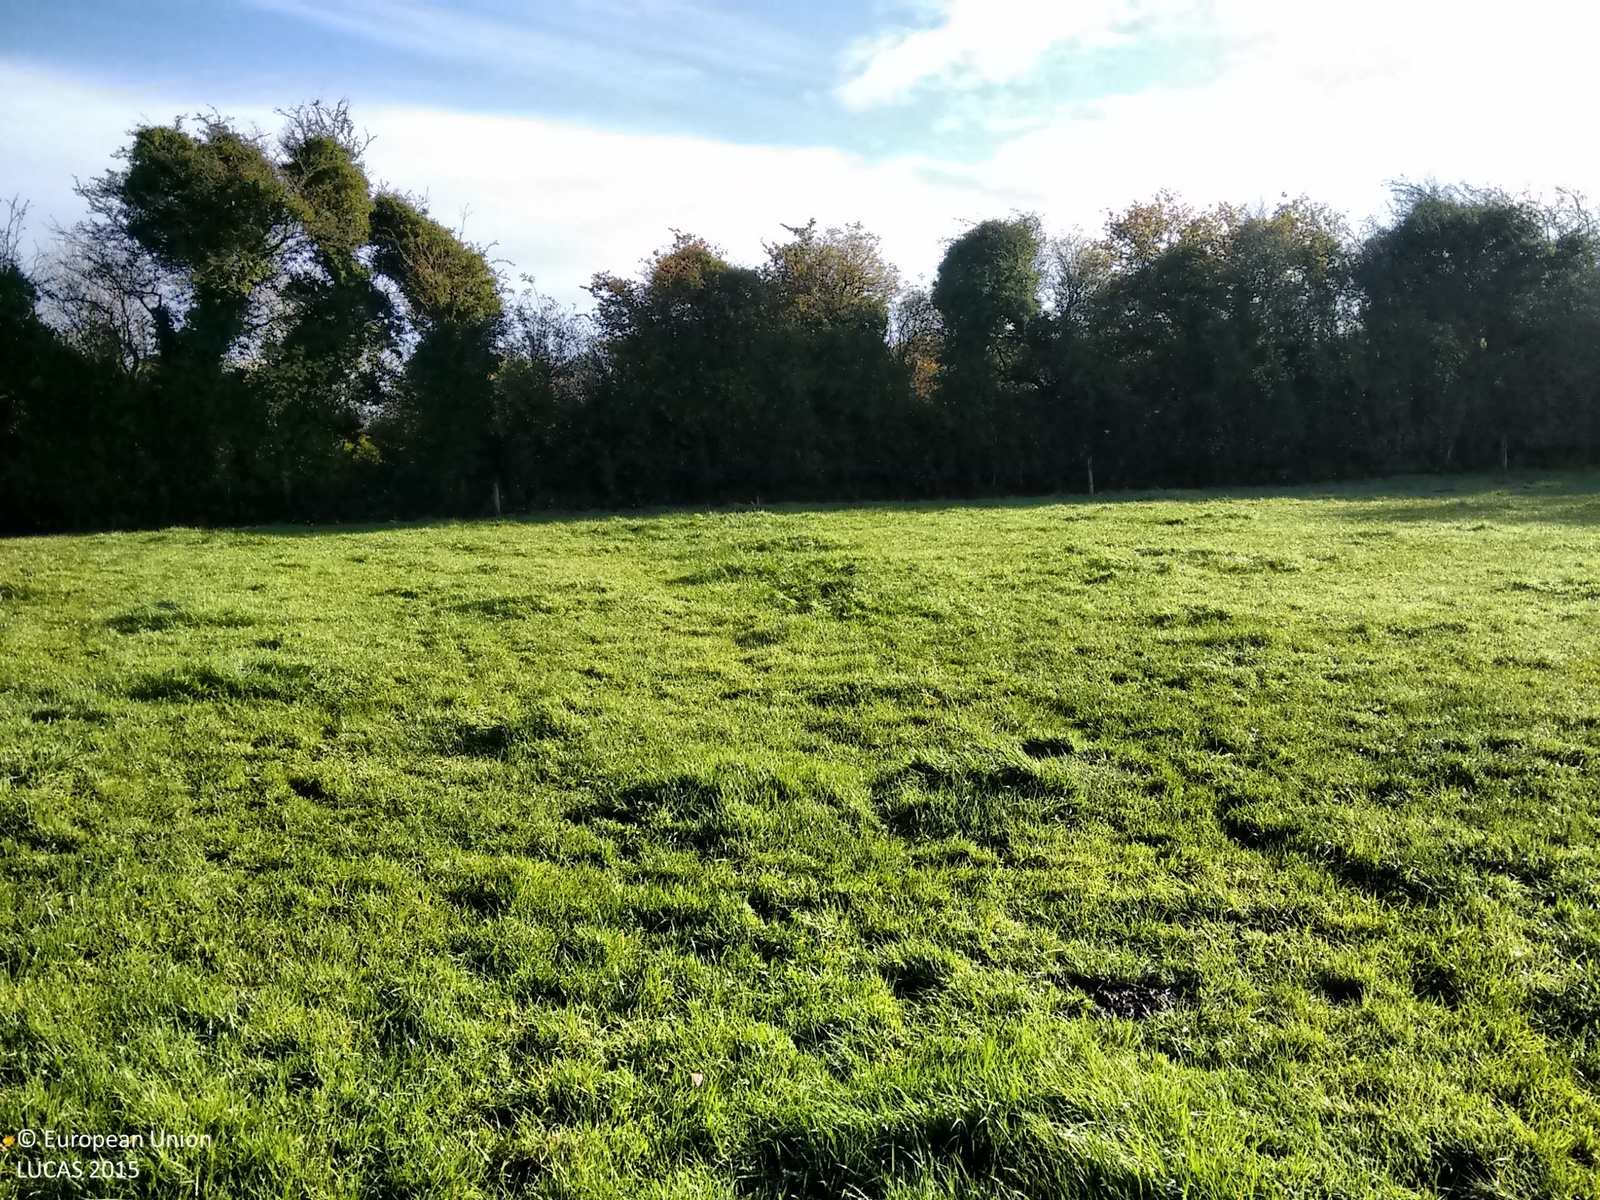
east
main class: Grassland
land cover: Grassland without tree/shrub cover
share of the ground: > 75 %
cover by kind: herbaceous plants 100 %
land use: Agriculture (excluding fallow land and kitchen gardens)
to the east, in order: Grassland without tree/shrub cover; Fences; Managed hedges; Grassland without tree/shrub cover; Managed hedges; Grassland without tree/shrub cover; Fences; Grassland without tree/shrub cover; Managed hedges; Electric lines; Fences; Grassland without tree/shrub cover; Fences; Grassland without tree/shrub cover
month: October
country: IE
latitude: 53.2855
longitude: -7.5446
